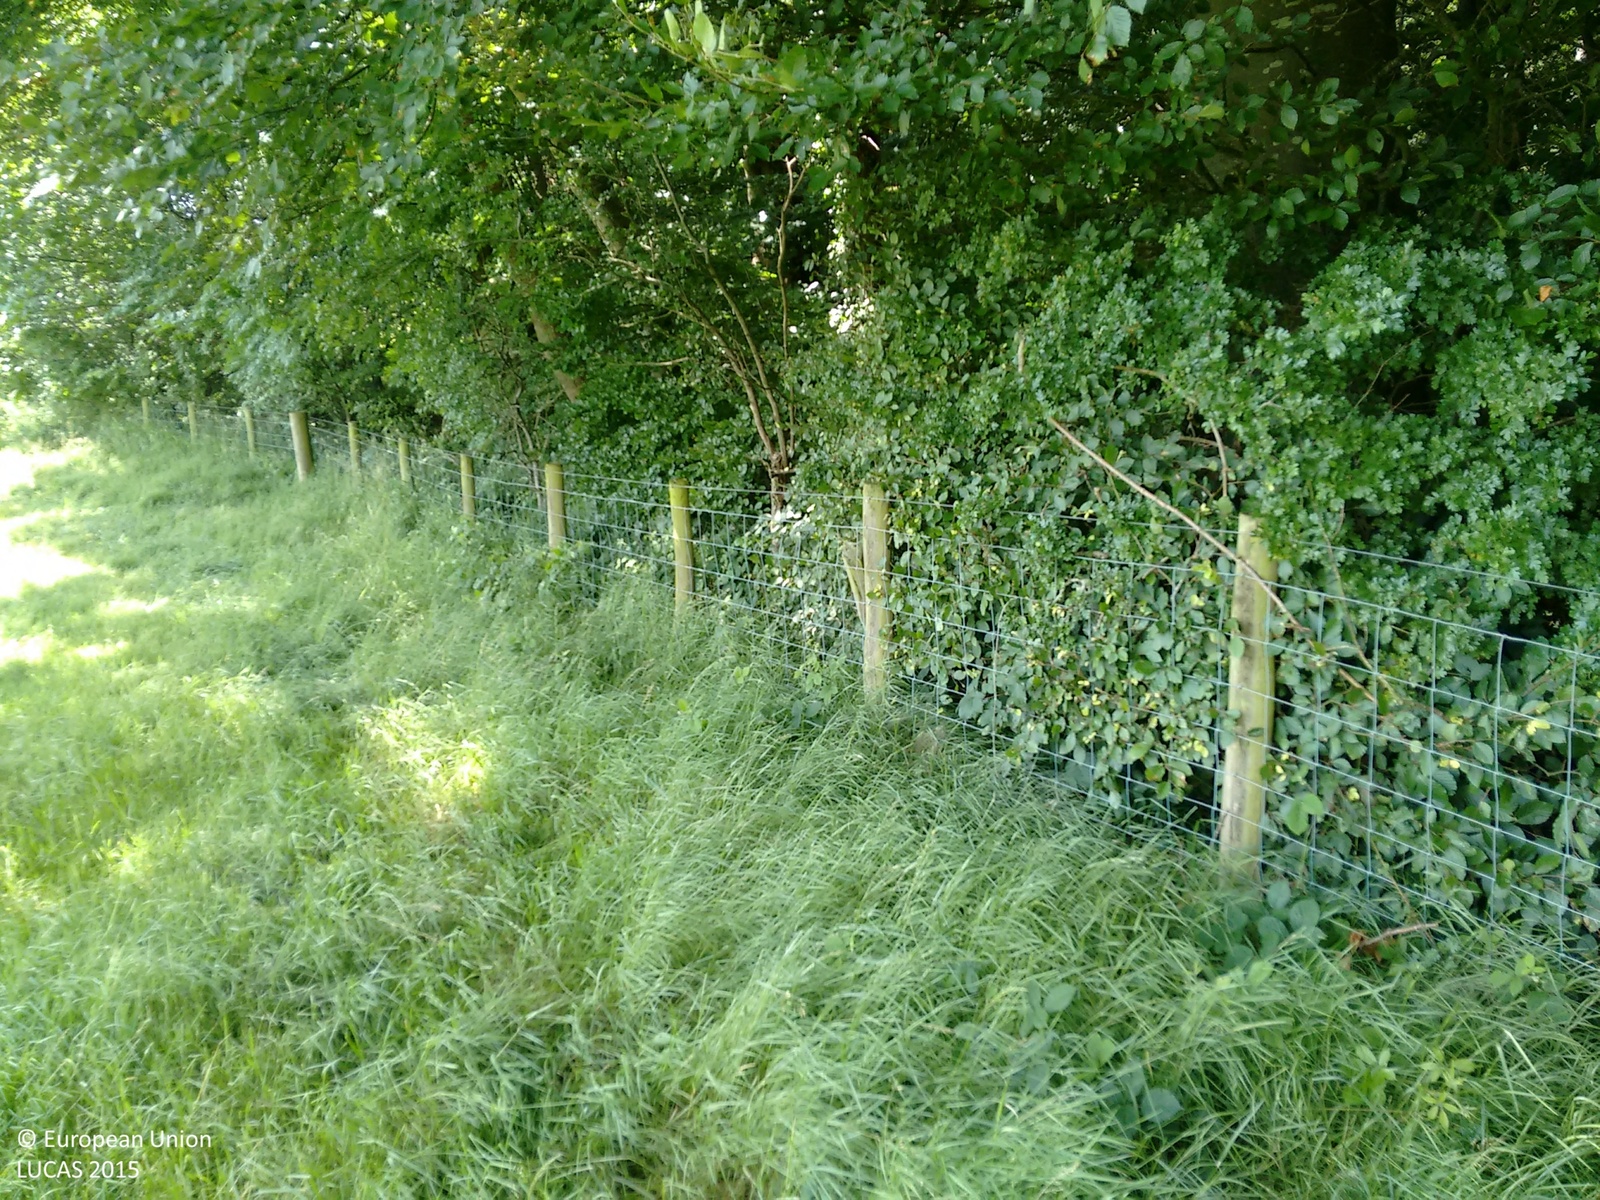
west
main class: Grassland
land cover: Grassland without tree/shrub cover
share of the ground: > 75 %
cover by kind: herbaceous plants 100 %
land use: Agriculture (excluding fallow land and kitchen gardens)
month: July
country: GB
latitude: 55.0034
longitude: -3.2556
